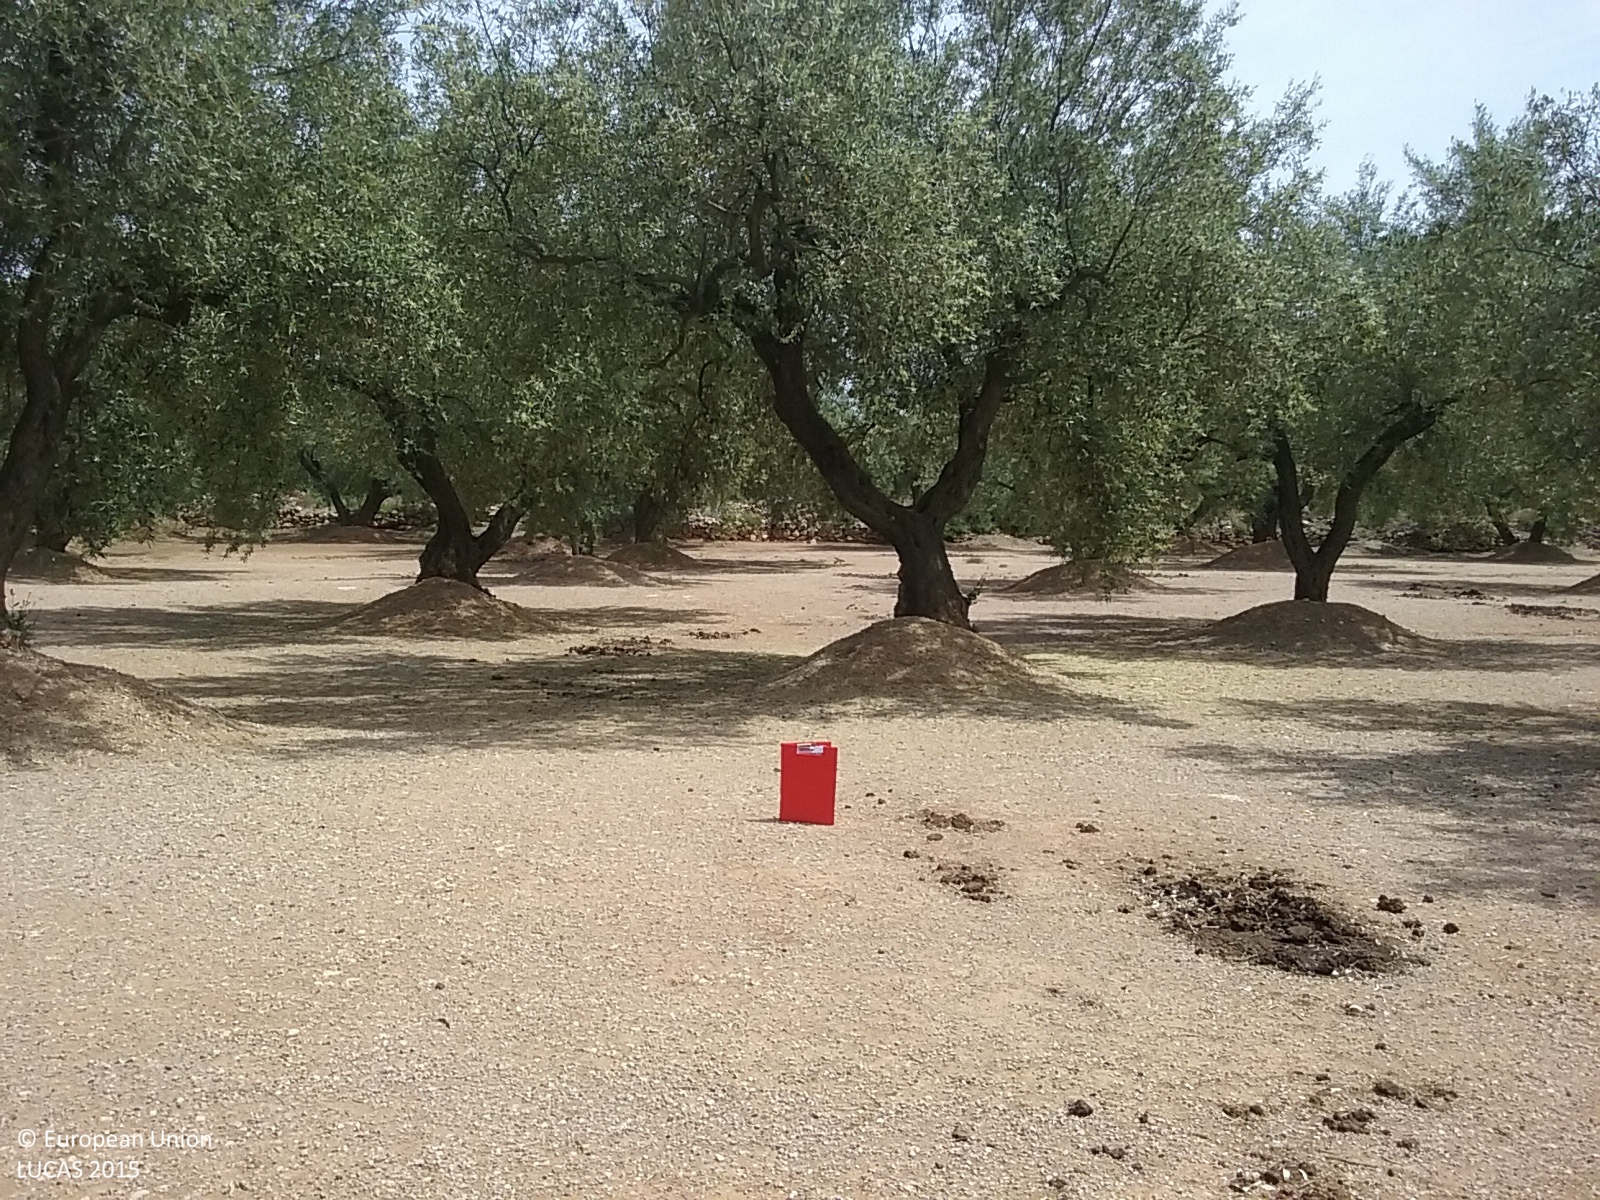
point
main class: Cropland
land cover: Olive groves
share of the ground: 50 - 75 %
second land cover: Other bare soil
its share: > 75 %
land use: Agriculture (excluding fallow land and kitchen gardens)
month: May
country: ES
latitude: 40.6671
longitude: 0.3774
